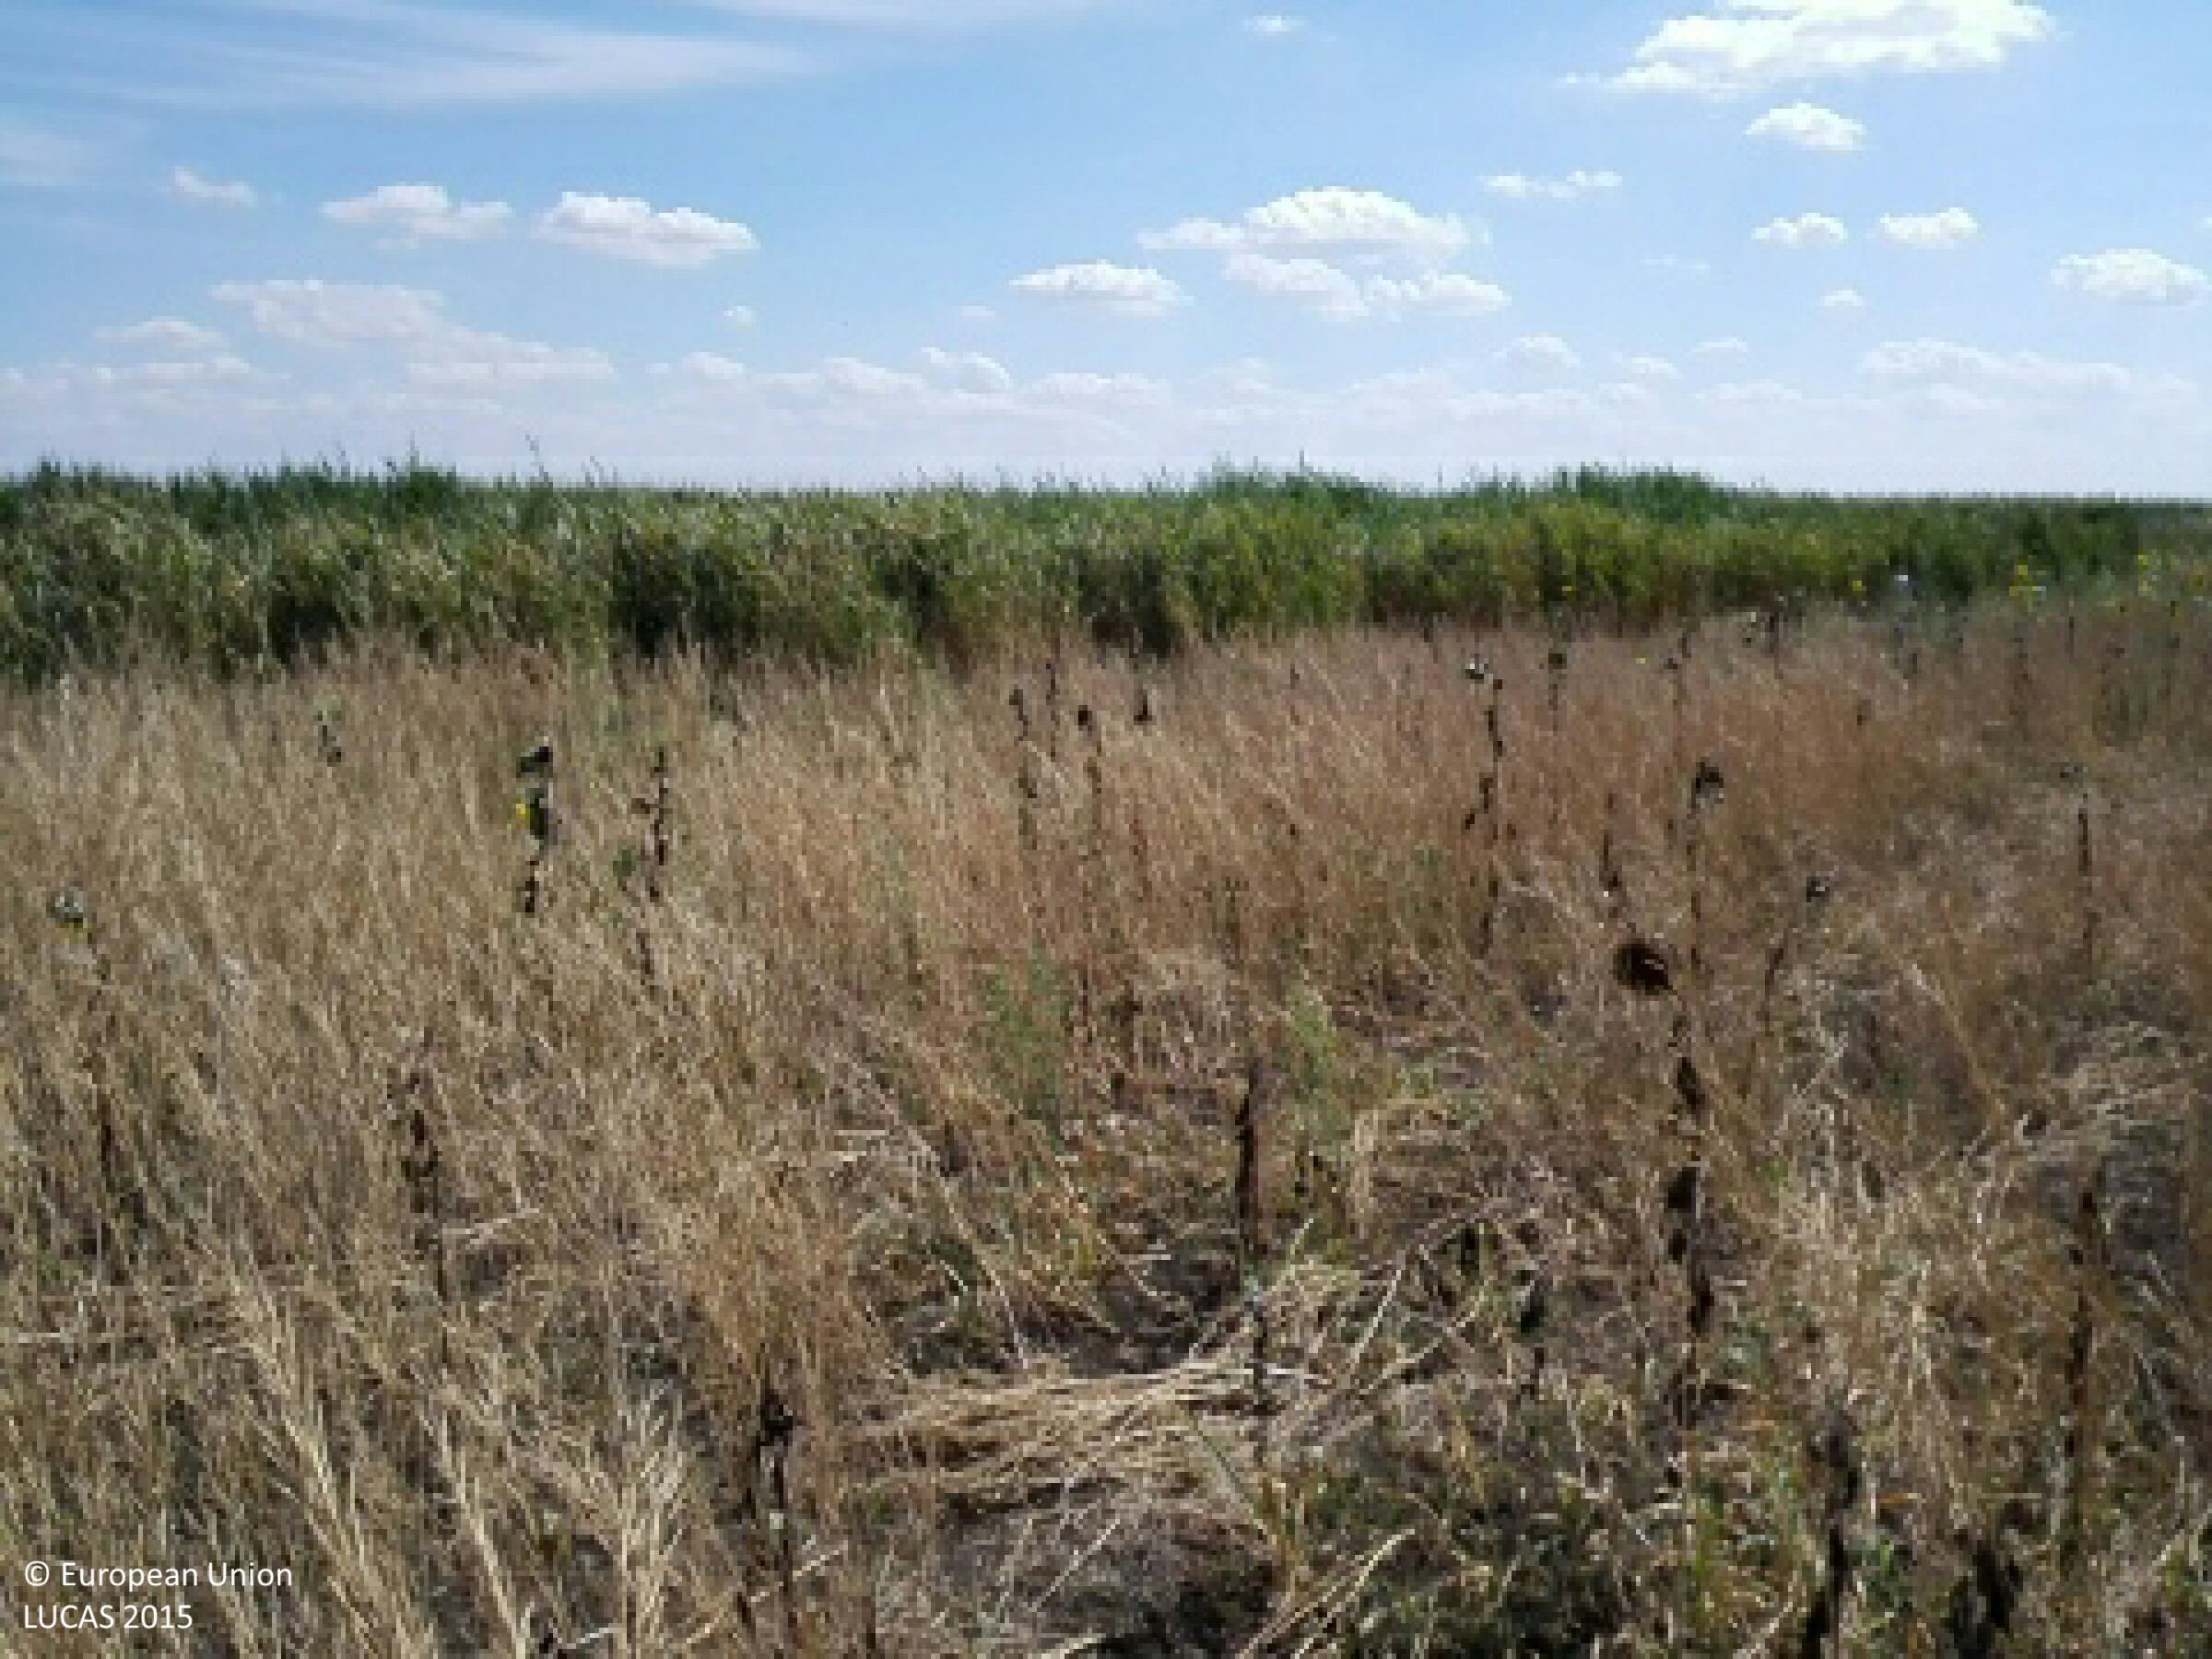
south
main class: Cropland
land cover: Rape and turnip rape
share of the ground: > 75 %
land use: Agriculture (excluding fallow land and kitchen gardens)
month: July
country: HU
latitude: 47.3848
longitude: 21.3125
